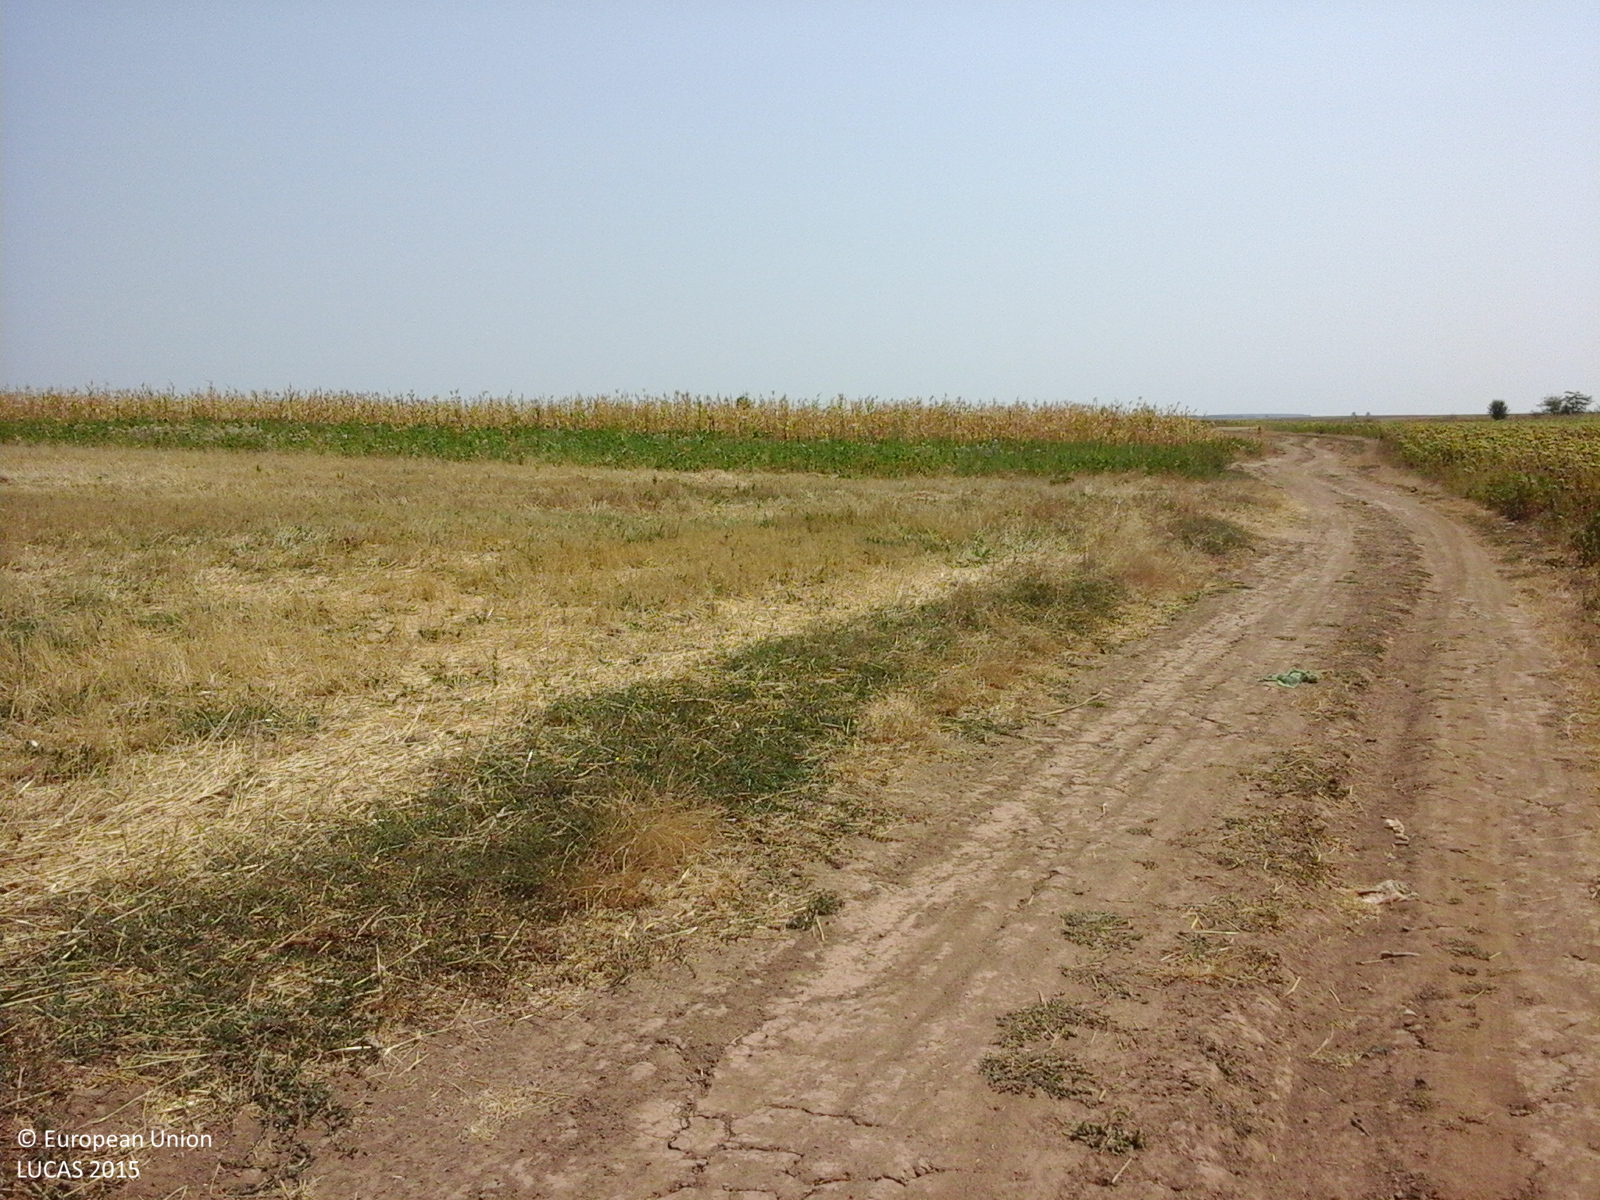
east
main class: Cropland
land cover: Sunflower
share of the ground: > 75 %
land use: Agriculture (excluding fallow land and kitchen gardens)
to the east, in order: Sunflower; Grass margins; Ditches and canals; Grass margins; Tracks; Grass margins; Lines of trees; Grass margins; Common wheat
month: August
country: RO
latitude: 44.2650
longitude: 23.2379
